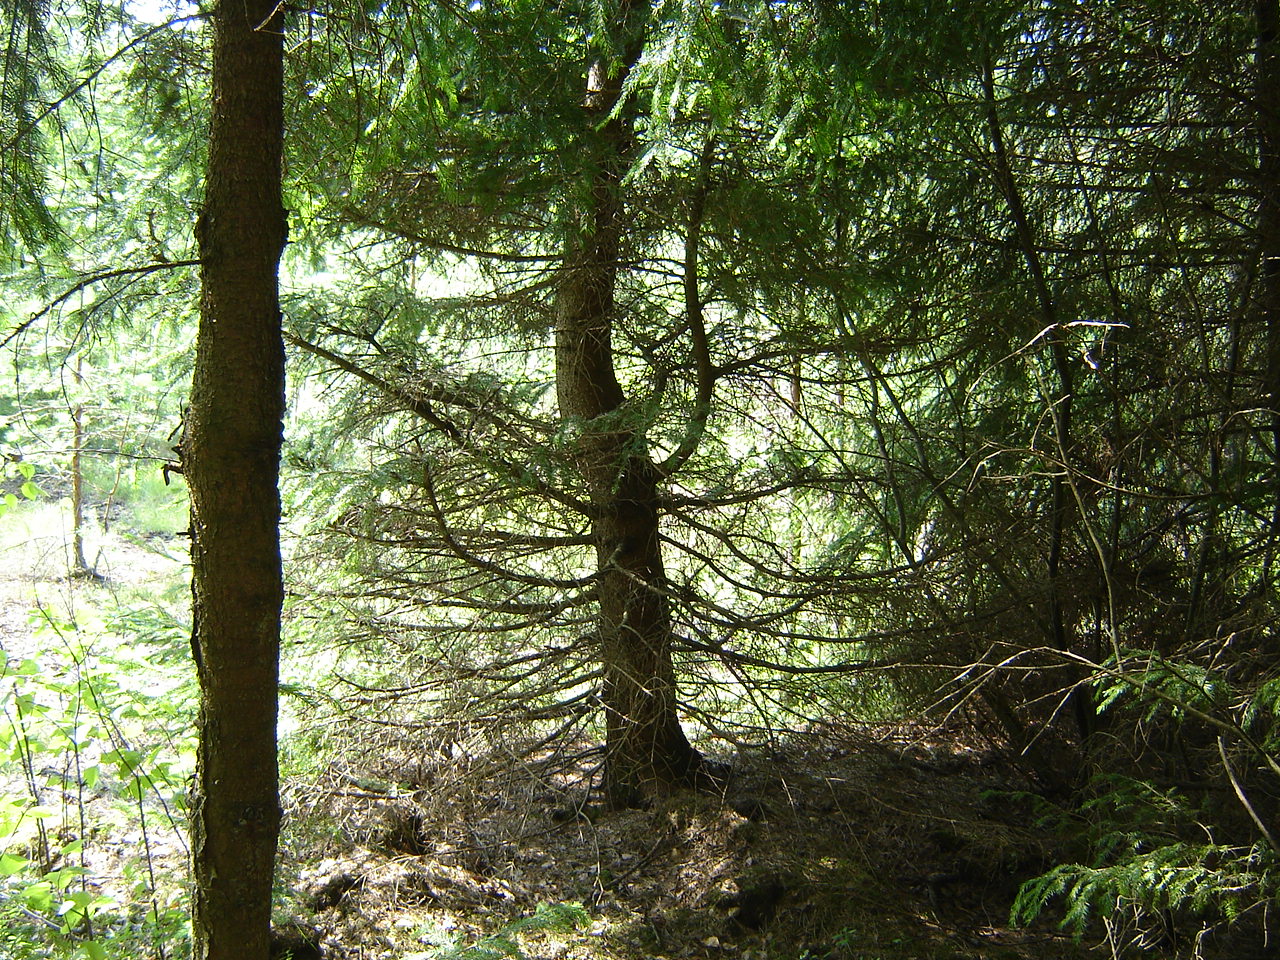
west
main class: Woodland
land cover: Other mixed woodland
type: hemiboreal forest and nemoral coniferous forest and mixed broadleaved-coniferous forest
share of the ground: > 75 %
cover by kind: broadleaved forest trees 50 %, coniferous forest trees 45 %, lichens and mosses 5 %
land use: Forestry
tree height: > 5 m
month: August
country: LT
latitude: 55.0538
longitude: 24.9040
